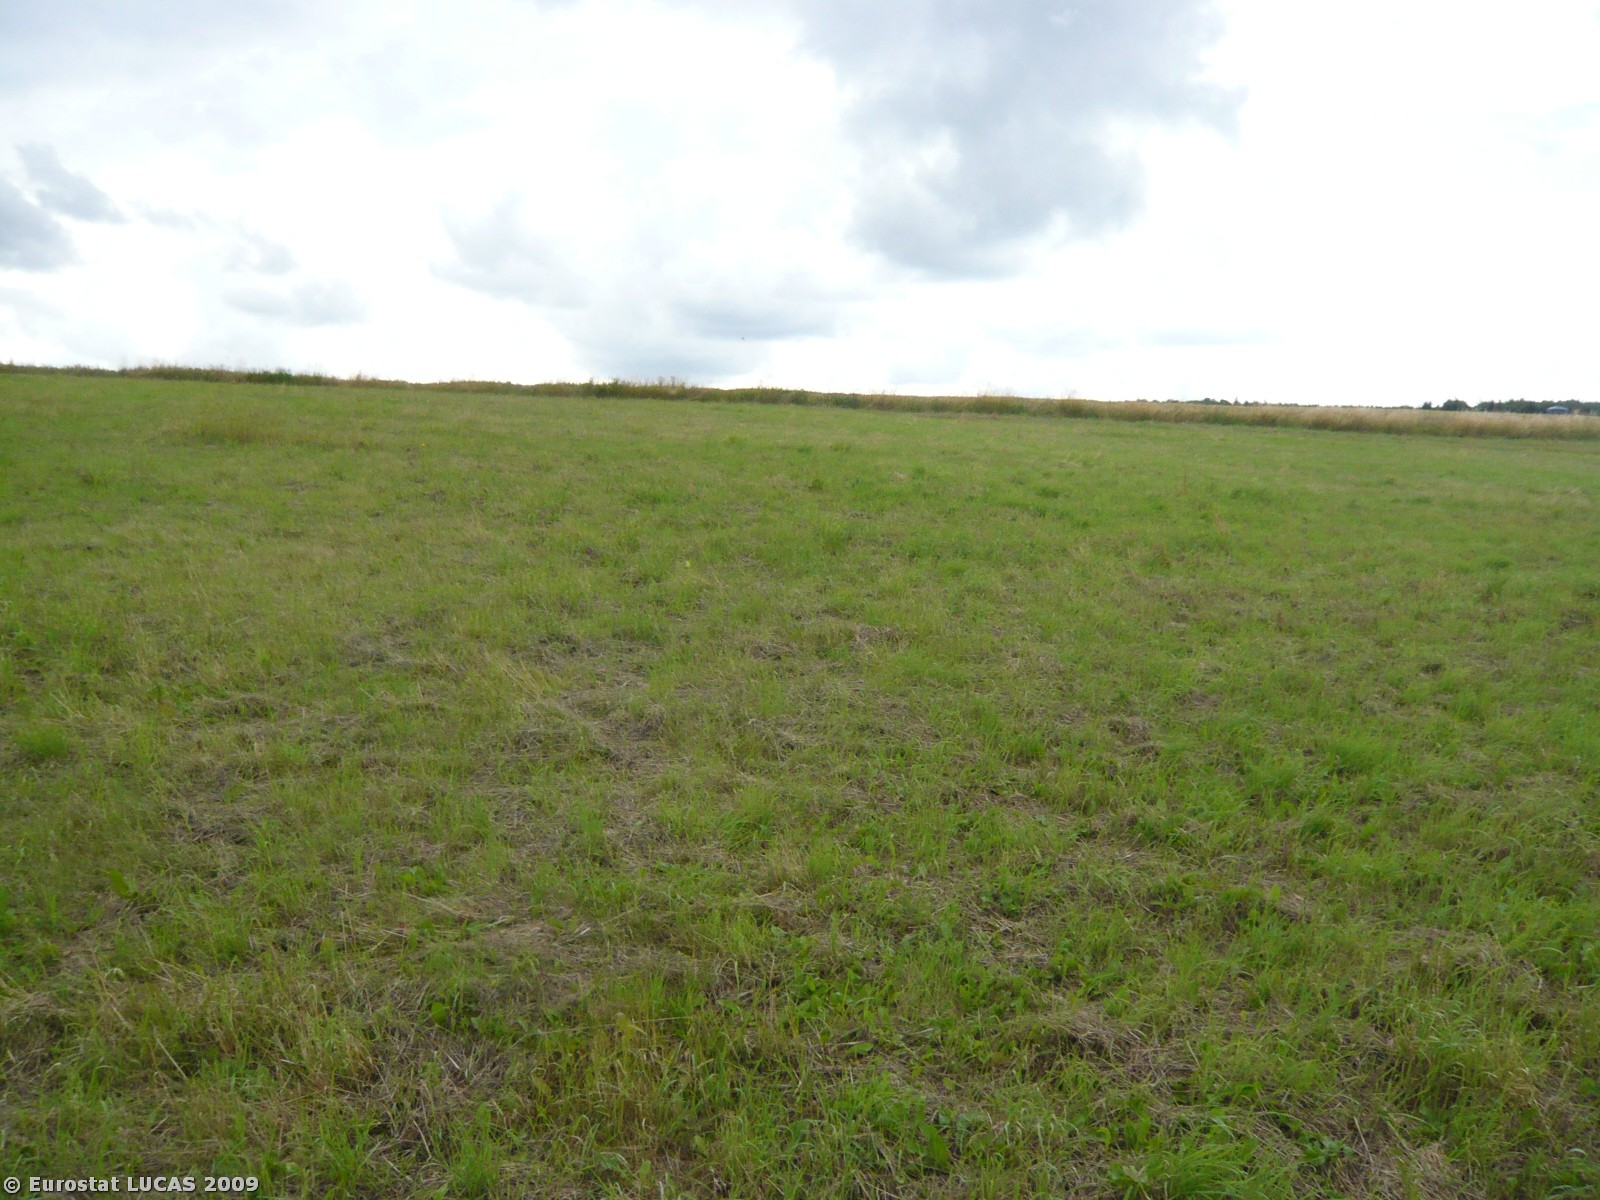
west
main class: Grassland
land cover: Grassland without tree/shrub cover
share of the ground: > 75 %
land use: Agriculture (excluding fallow land and kitchen gardens)
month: July
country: DK
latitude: 55.5252
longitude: 11.9785
